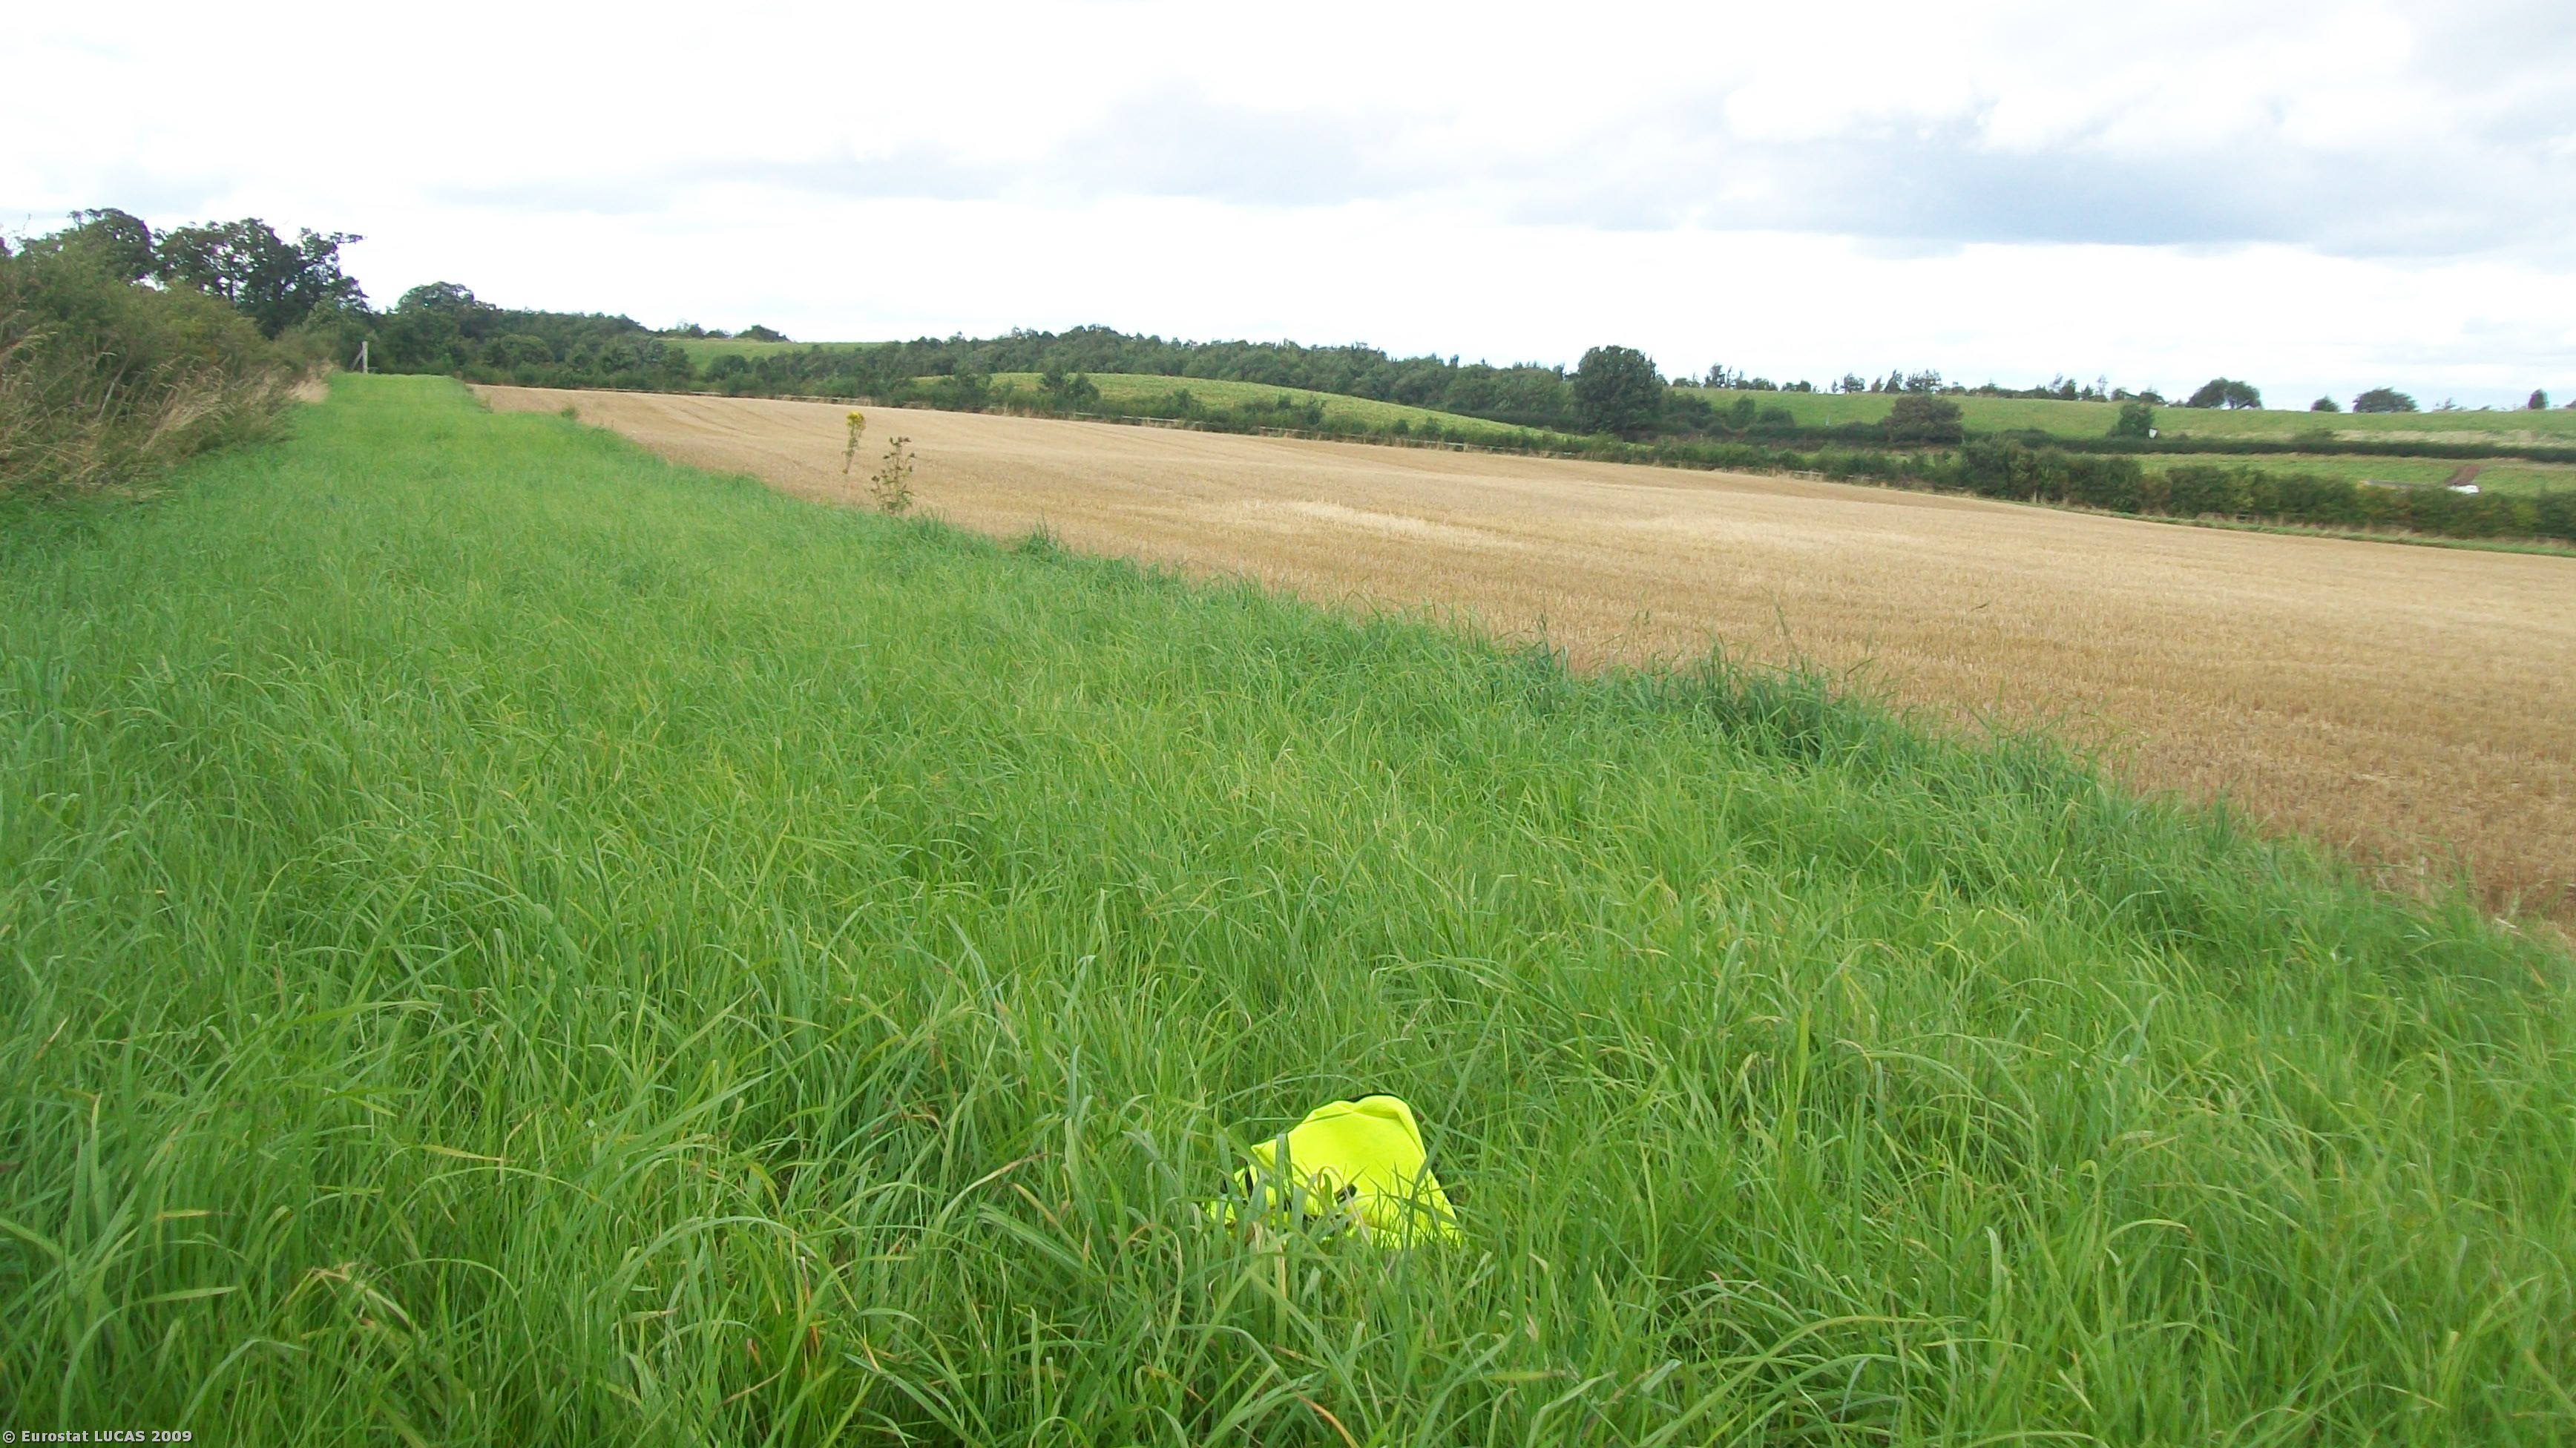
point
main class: Grassland
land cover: Grassland without tree/shrub cover
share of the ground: > 75 %
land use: Agriculture (excluding fallow land and kitchen gardens)
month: September
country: GB
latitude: 52.6892
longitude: -2.5686
